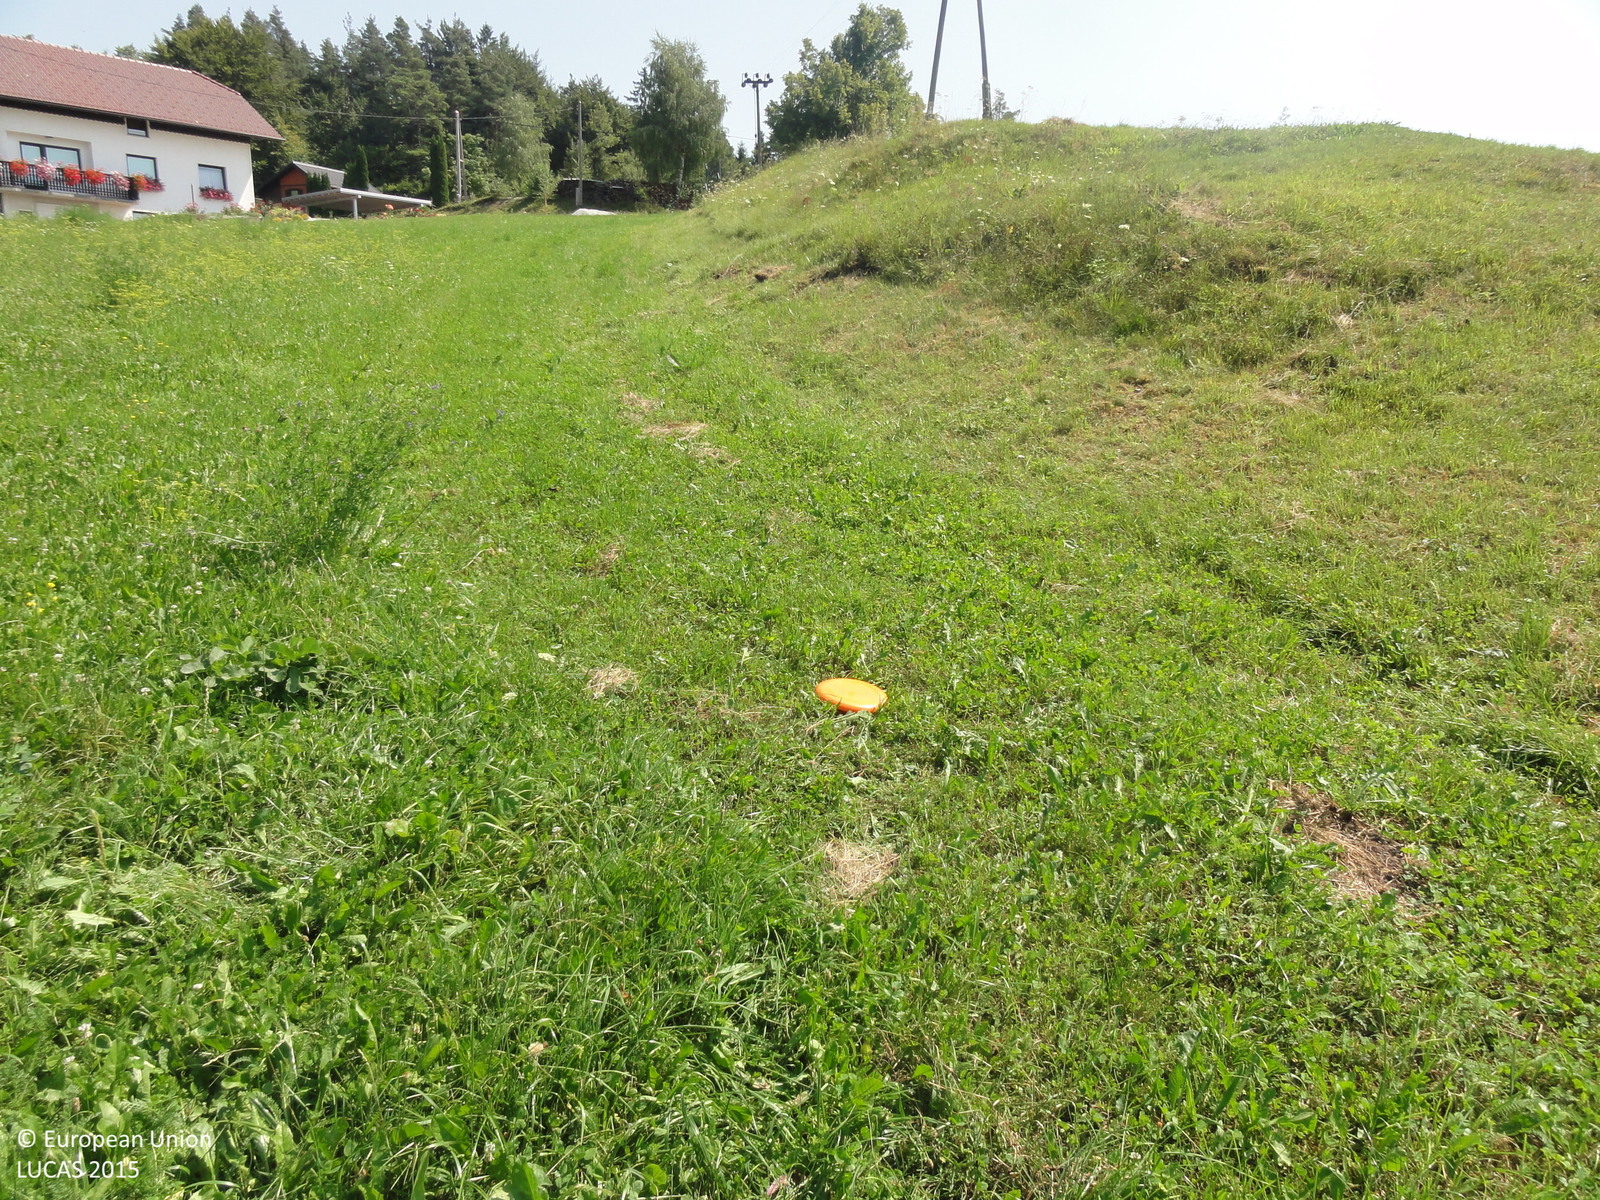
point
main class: Grassland
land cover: Grassland without tree/shrub cover
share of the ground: > 75 %
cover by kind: herbaceous plants 100 %
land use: Agriculture (excluding fallow land and kitchen gardens)
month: August
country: SI
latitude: 46.0347
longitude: 15.0230
